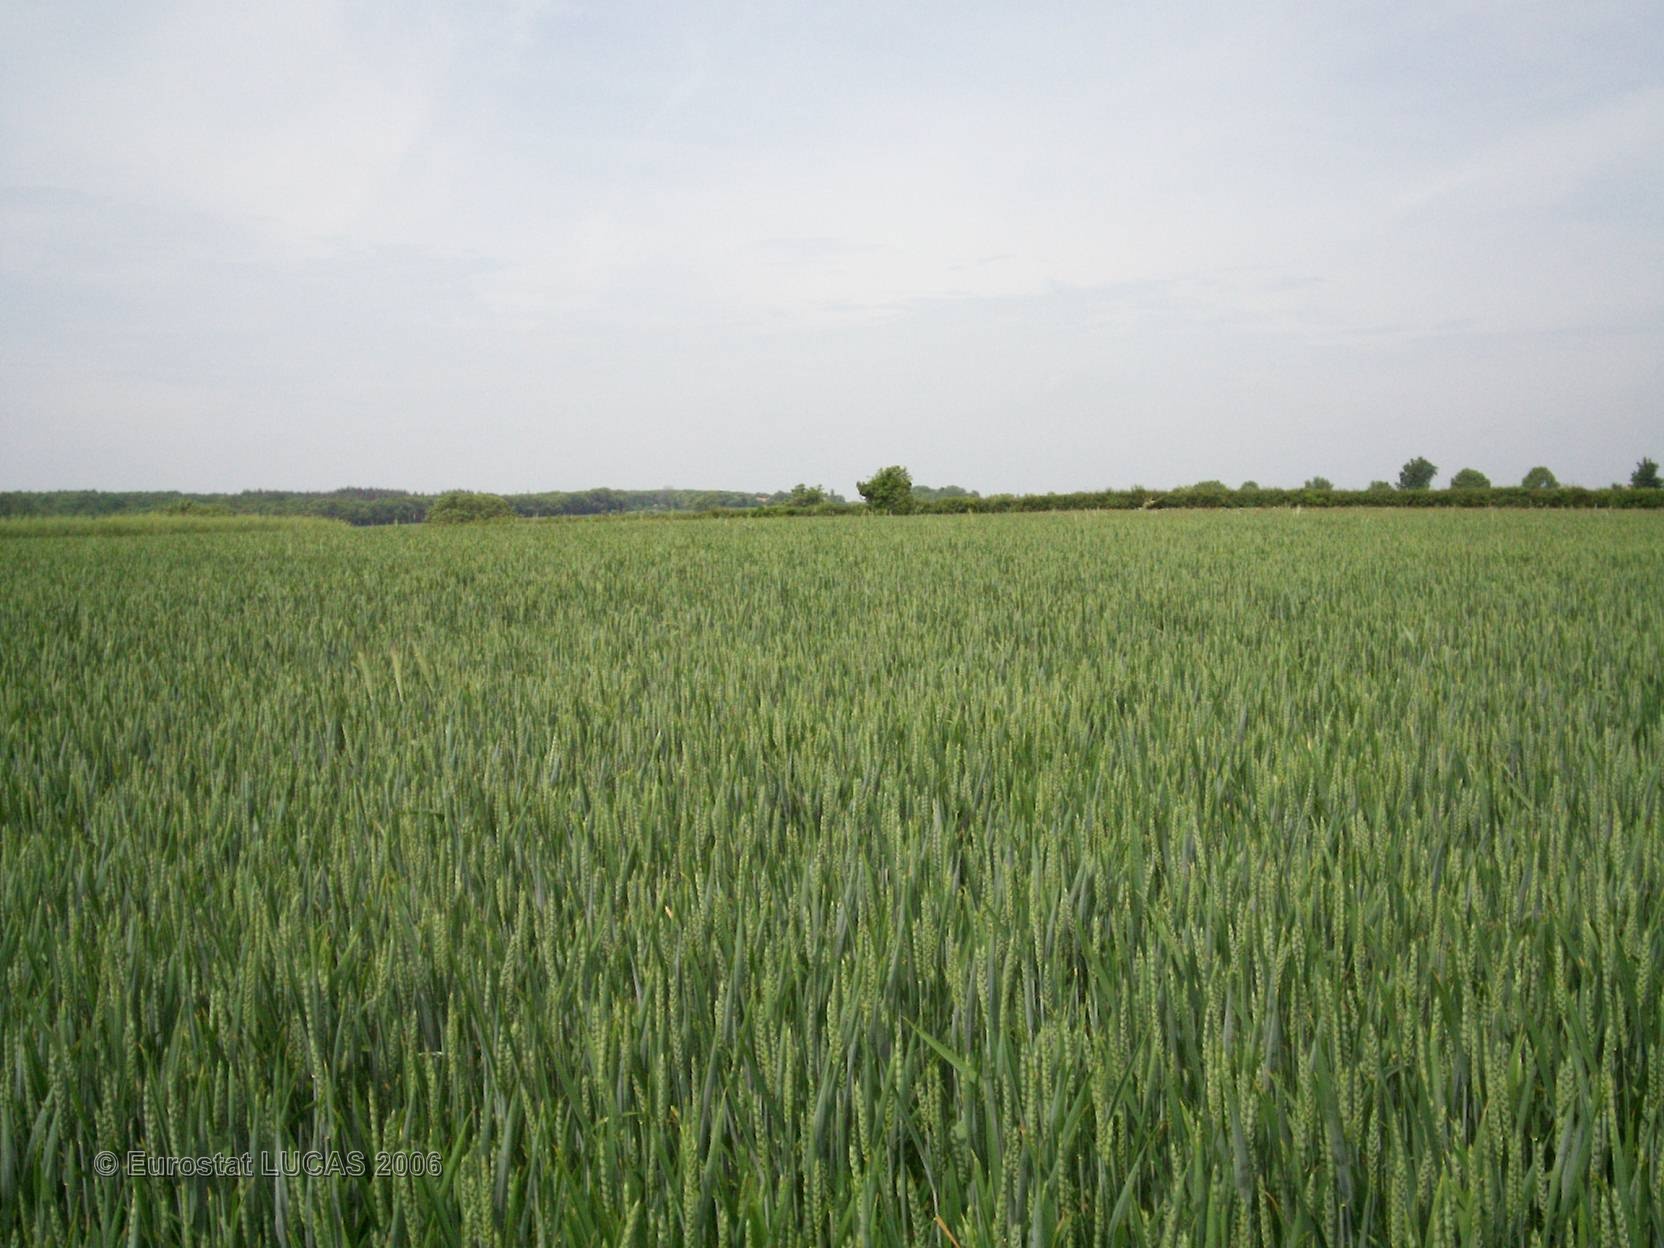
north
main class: Cropland
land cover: Common wheat
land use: Agriculture (excluding fallow land and kitchen gardens)
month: May
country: FR
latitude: 46.4698
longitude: -0.2996
